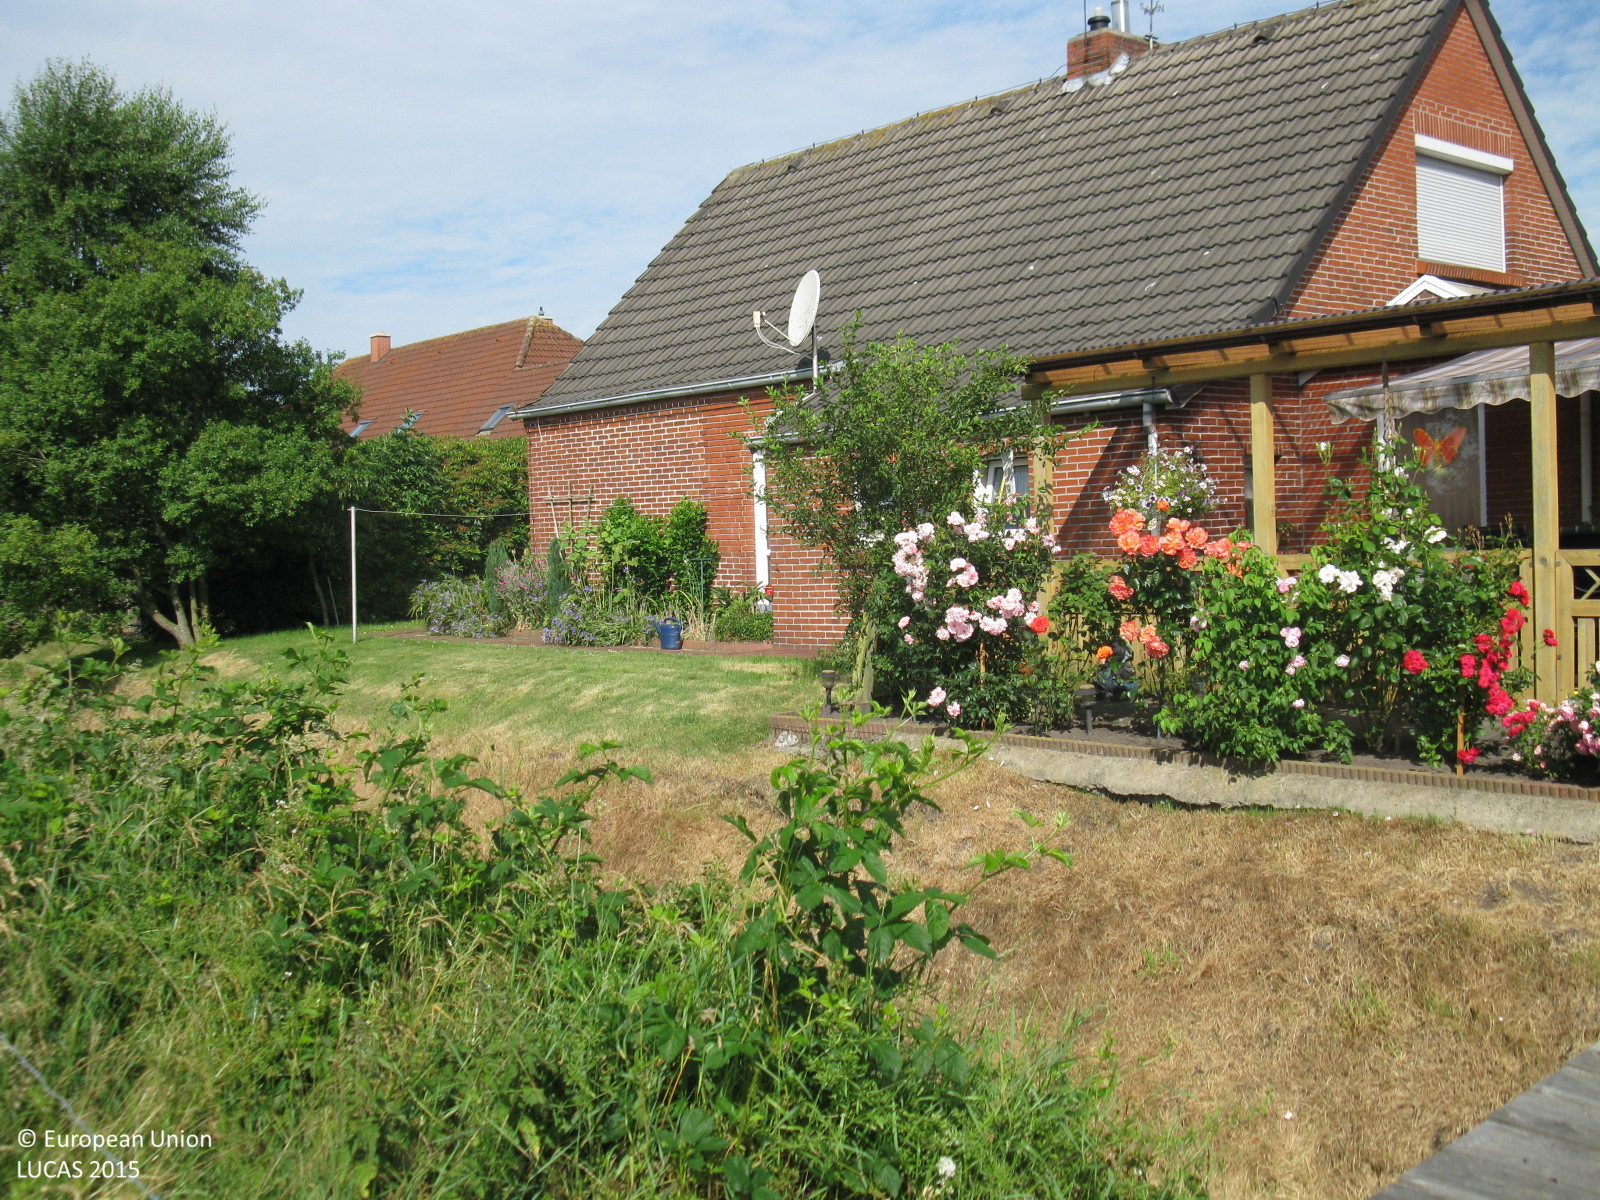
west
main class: Grassland
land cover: Grassland without tree/shrub cover
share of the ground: > 75 %
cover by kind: herbaceous plants 100 %
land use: Agriculture (excluding fallow land and kitchen gardens)
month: July
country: DE
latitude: 53.4639
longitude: 7.3948
